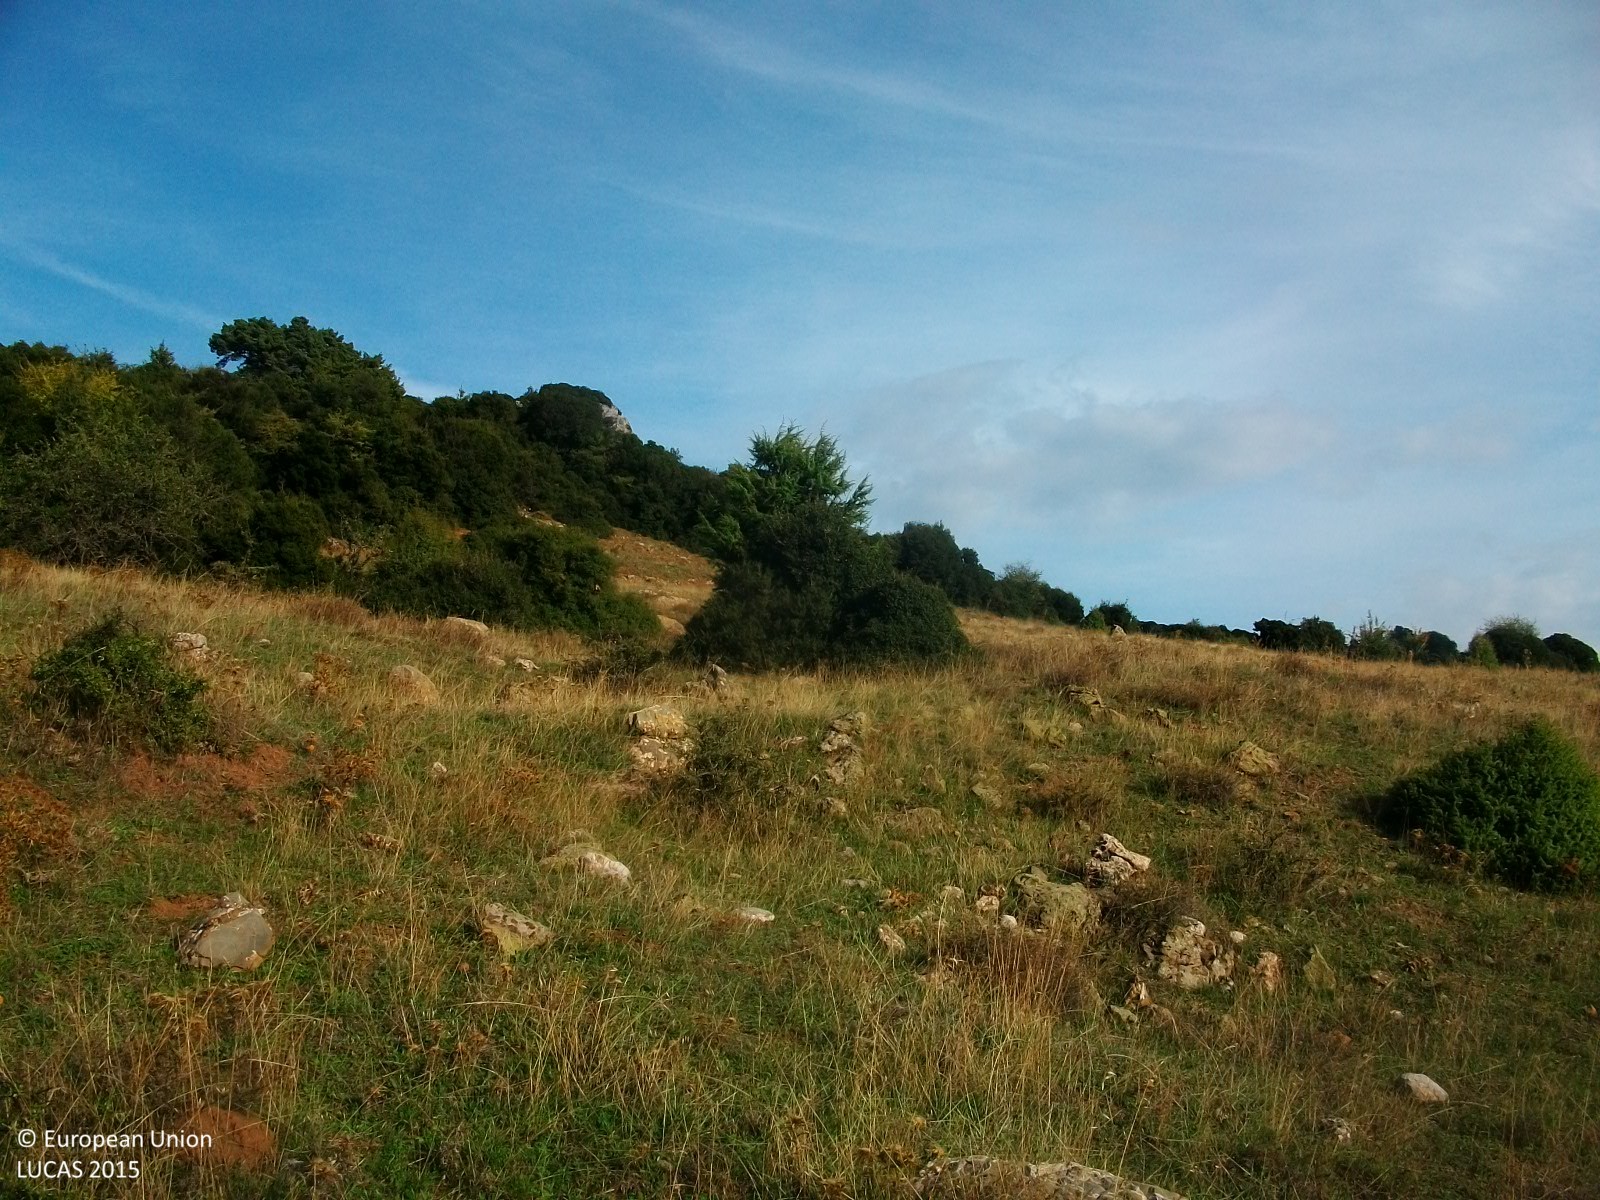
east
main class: Grassland
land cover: Grassland with sparse tree/shrub cover
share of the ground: > 75 %
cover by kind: herbaceous plants 80 %, unconsolidated bare surface 10 %, coniferous forest trees 5 %, shrubs 5 %
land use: Semi-natural and natural areas not in use
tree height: < 5 m
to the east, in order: Grassland with sparse tree/shrub cover; Spruce dominated coniferous woodland; Grassland with sparse tree/shrub cover
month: October
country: GR
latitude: 37.8860
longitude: 22.3950
